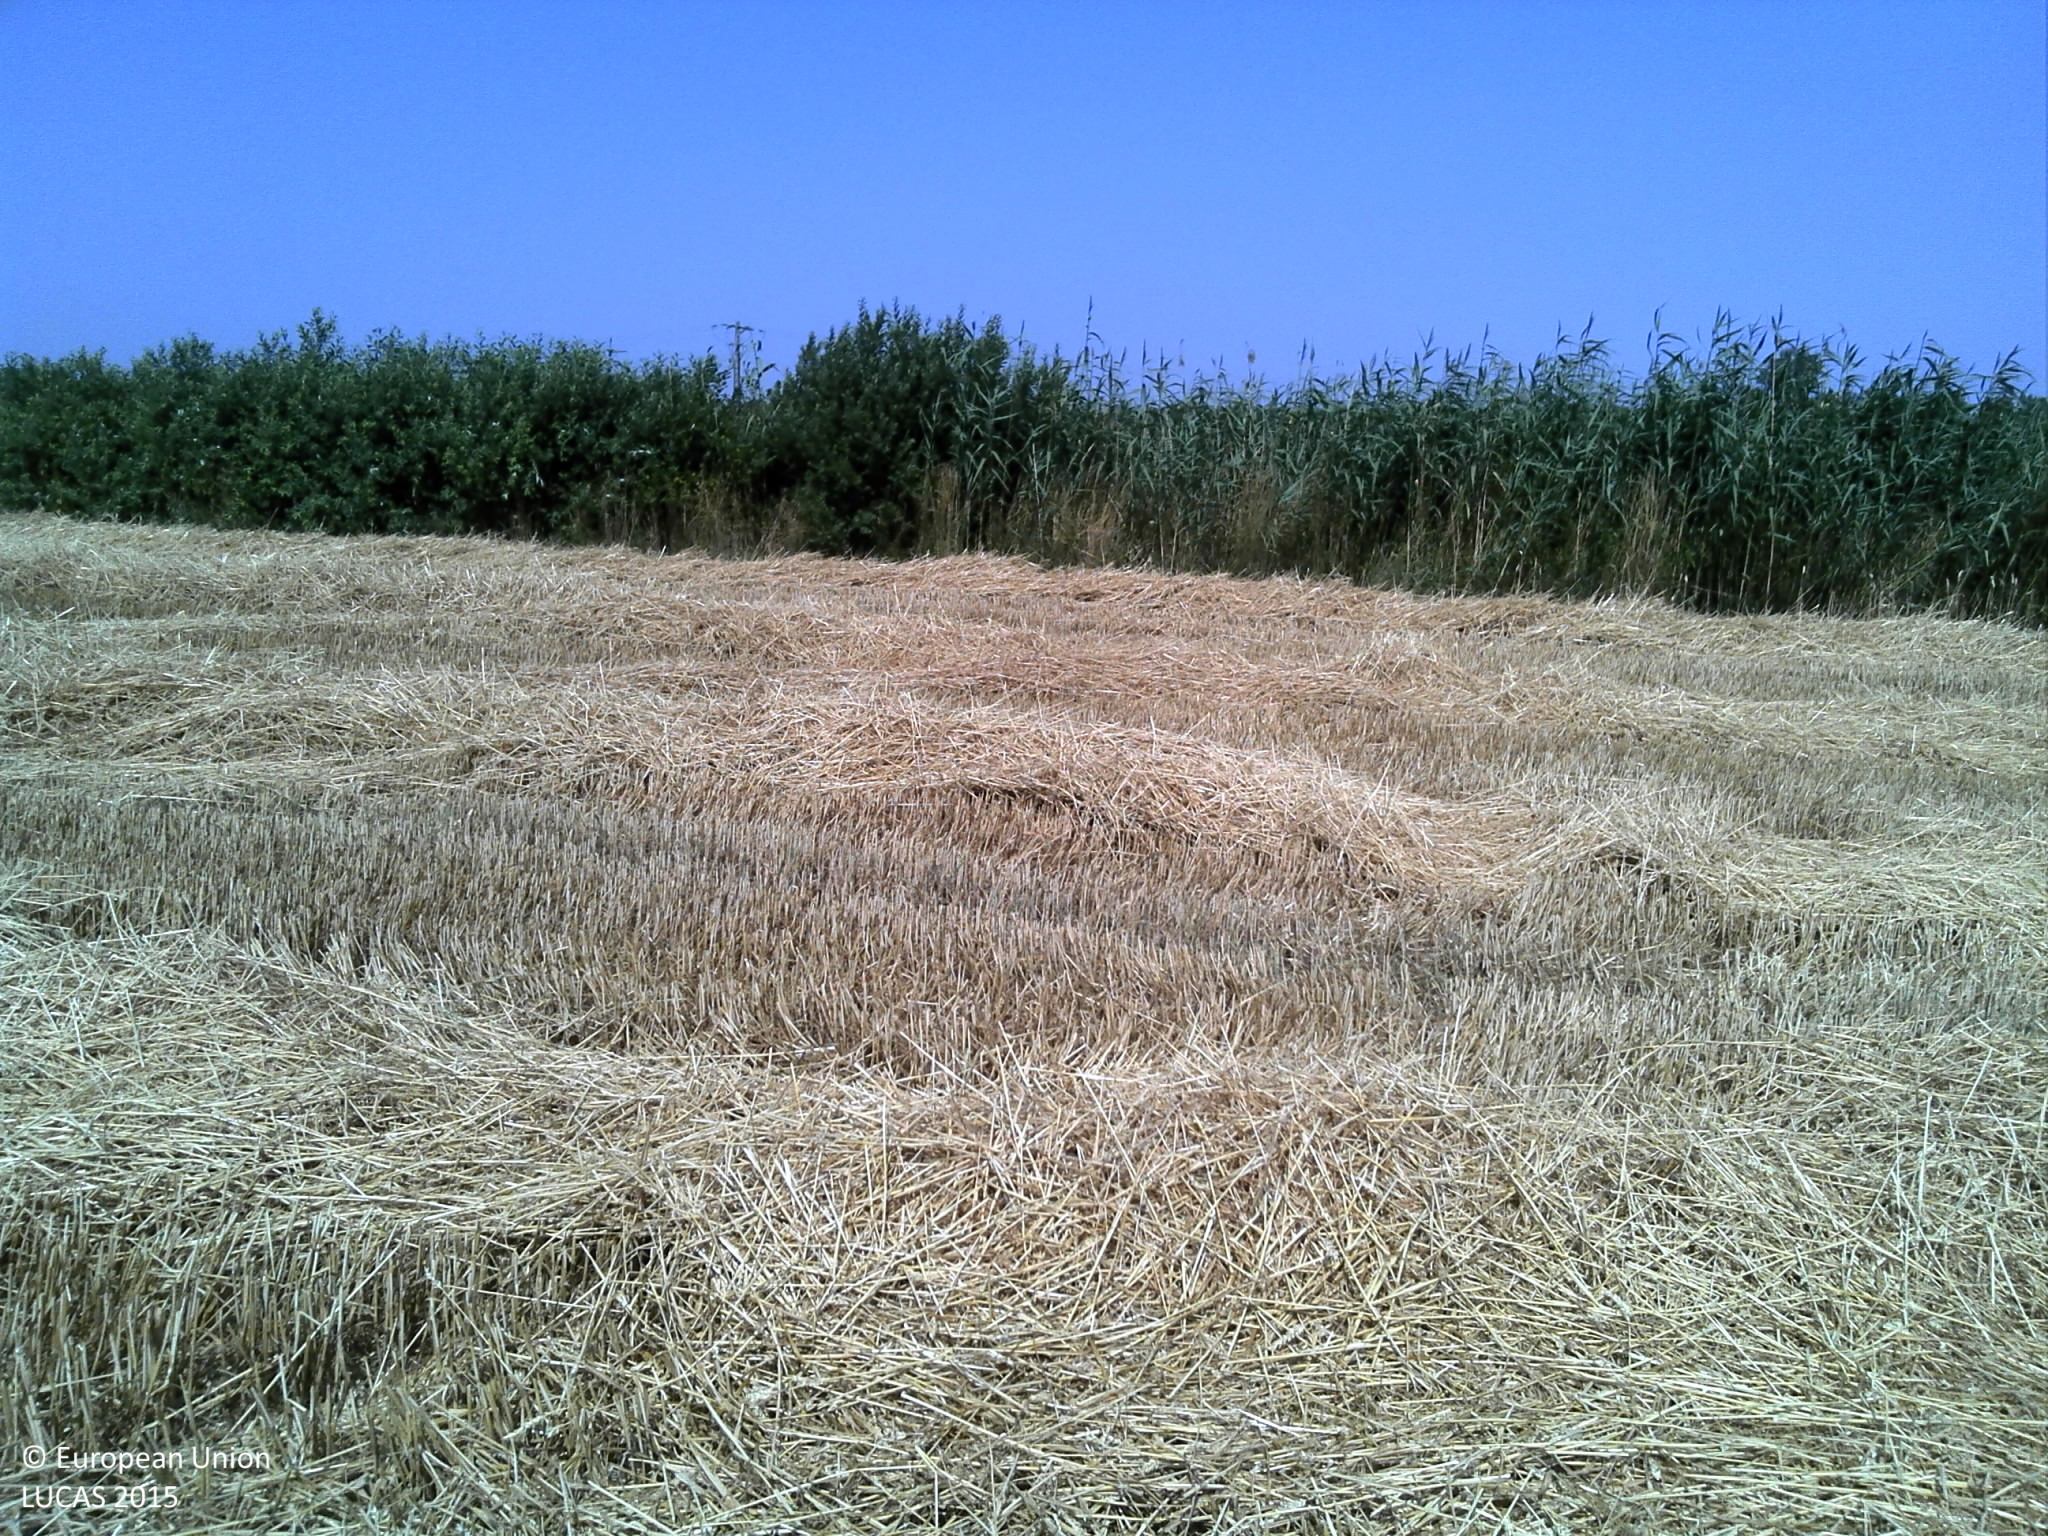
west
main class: Cropland
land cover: Common wheat
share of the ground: > 75 %
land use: Agriculture (excluding fallow land and kitchen gardens)
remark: Harvested field
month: July
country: FR
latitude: 48.7903
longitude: 4.8935
